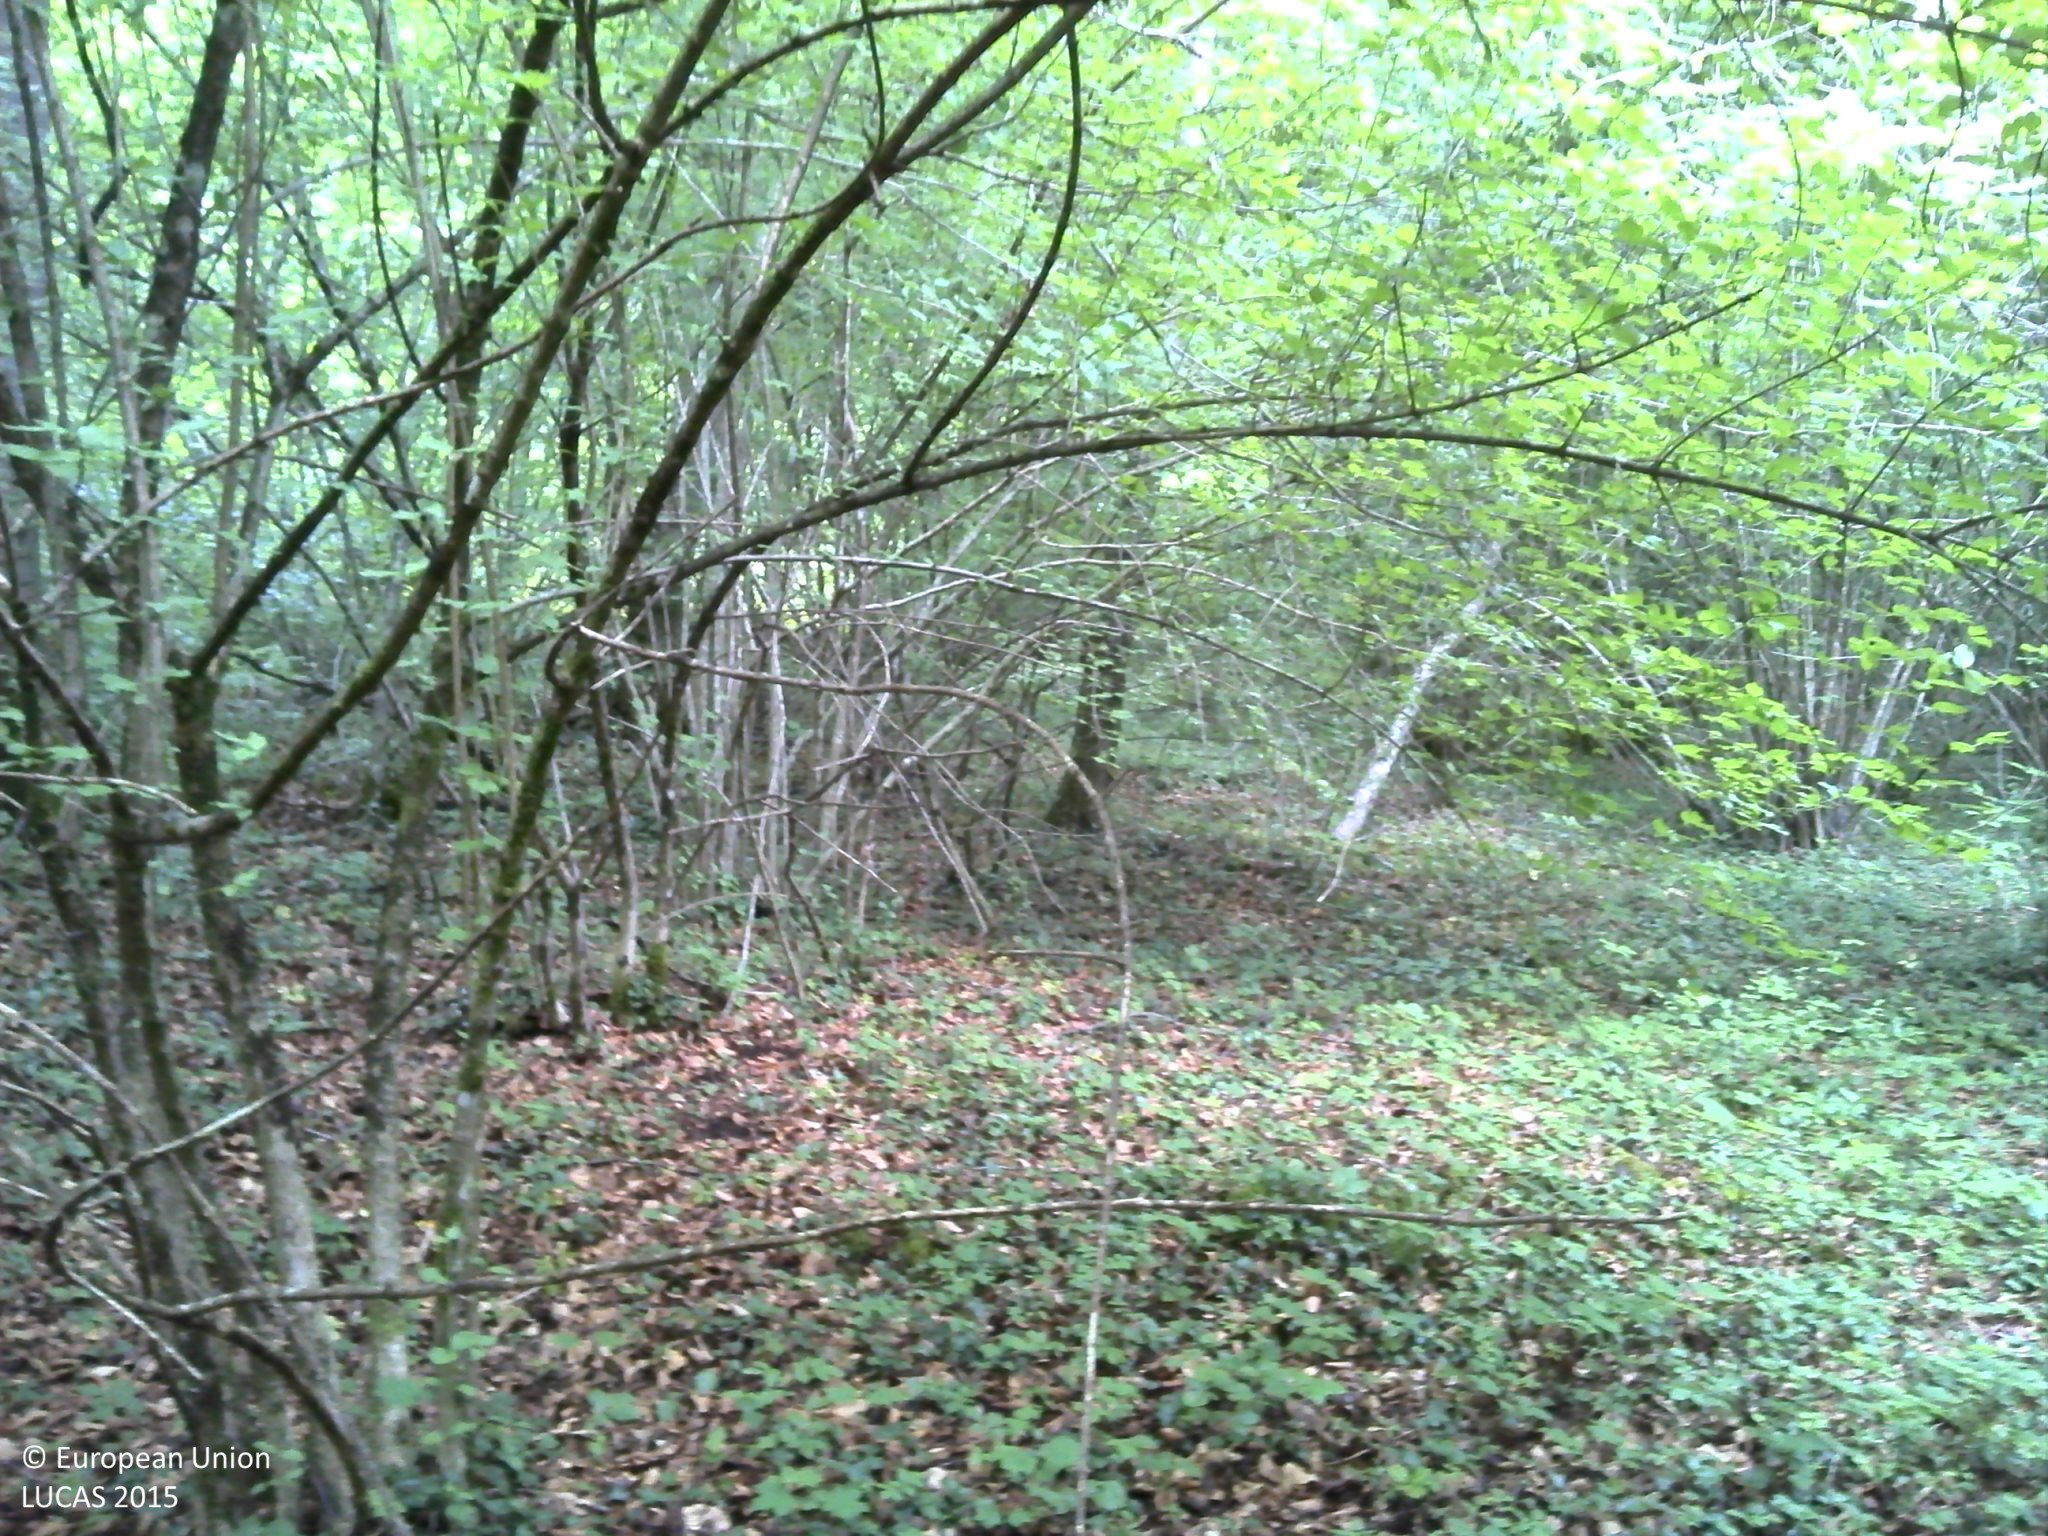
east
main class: Woodland
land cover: Broadleaved woodland
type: beech forest
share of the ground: 50 - 75 %
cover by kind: broadleaved forest trees 70 %, herbaceous plants 20 %, consolidated bare surface 10 %
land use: Forestry
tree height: > 5 m
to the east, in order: Broadleaved woodland
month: June
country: FR
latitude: 49.6321
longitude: 4.7772
